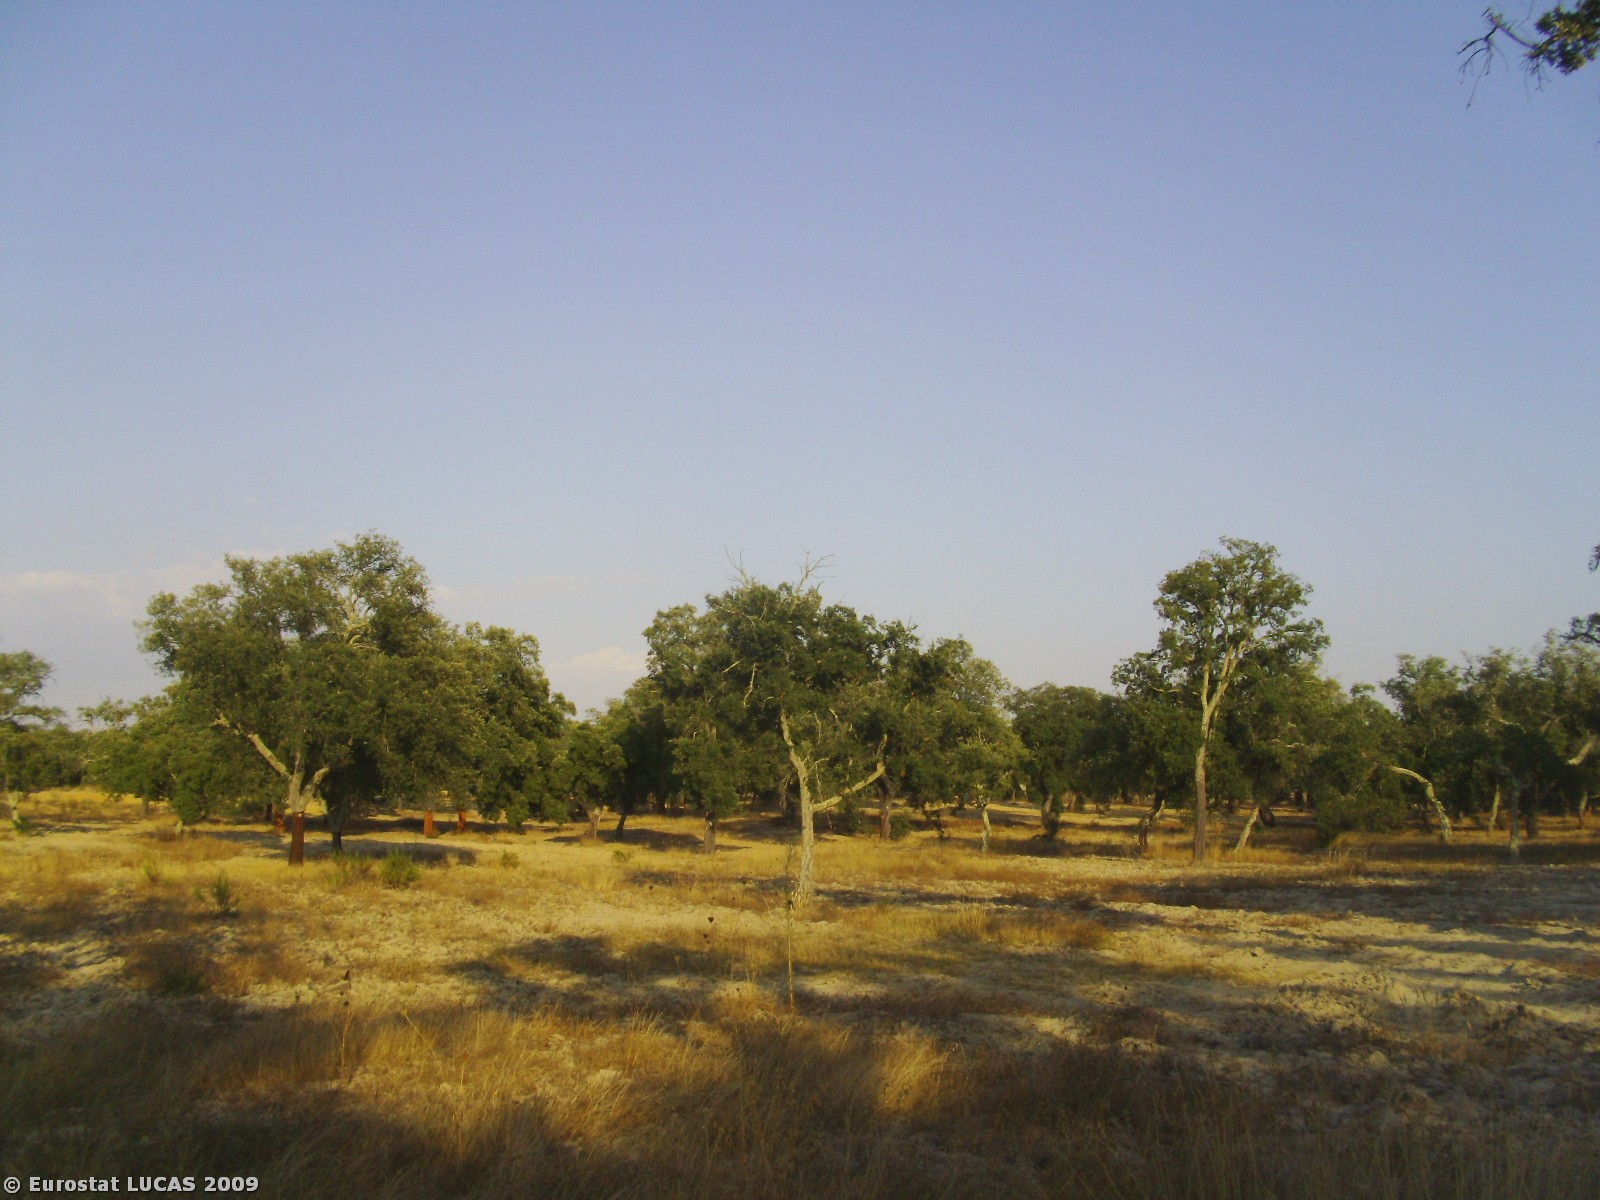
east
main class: Woodland
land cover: Broadleaved woodland
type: broadleaved evergreen forest
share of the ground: 25 - 50 %
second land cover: Spontaneously vegetated surfaces
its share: 50 - 75 %
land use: Forestry
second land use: Fallow land
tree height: > 5 m
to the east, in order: Broadleaved woodland; Spontaneously vegetated surfaces; Broadleaved woodland; Tracks; Broadleaved woodland
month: August
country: PT
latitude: 37.9466
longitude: -8.4414
